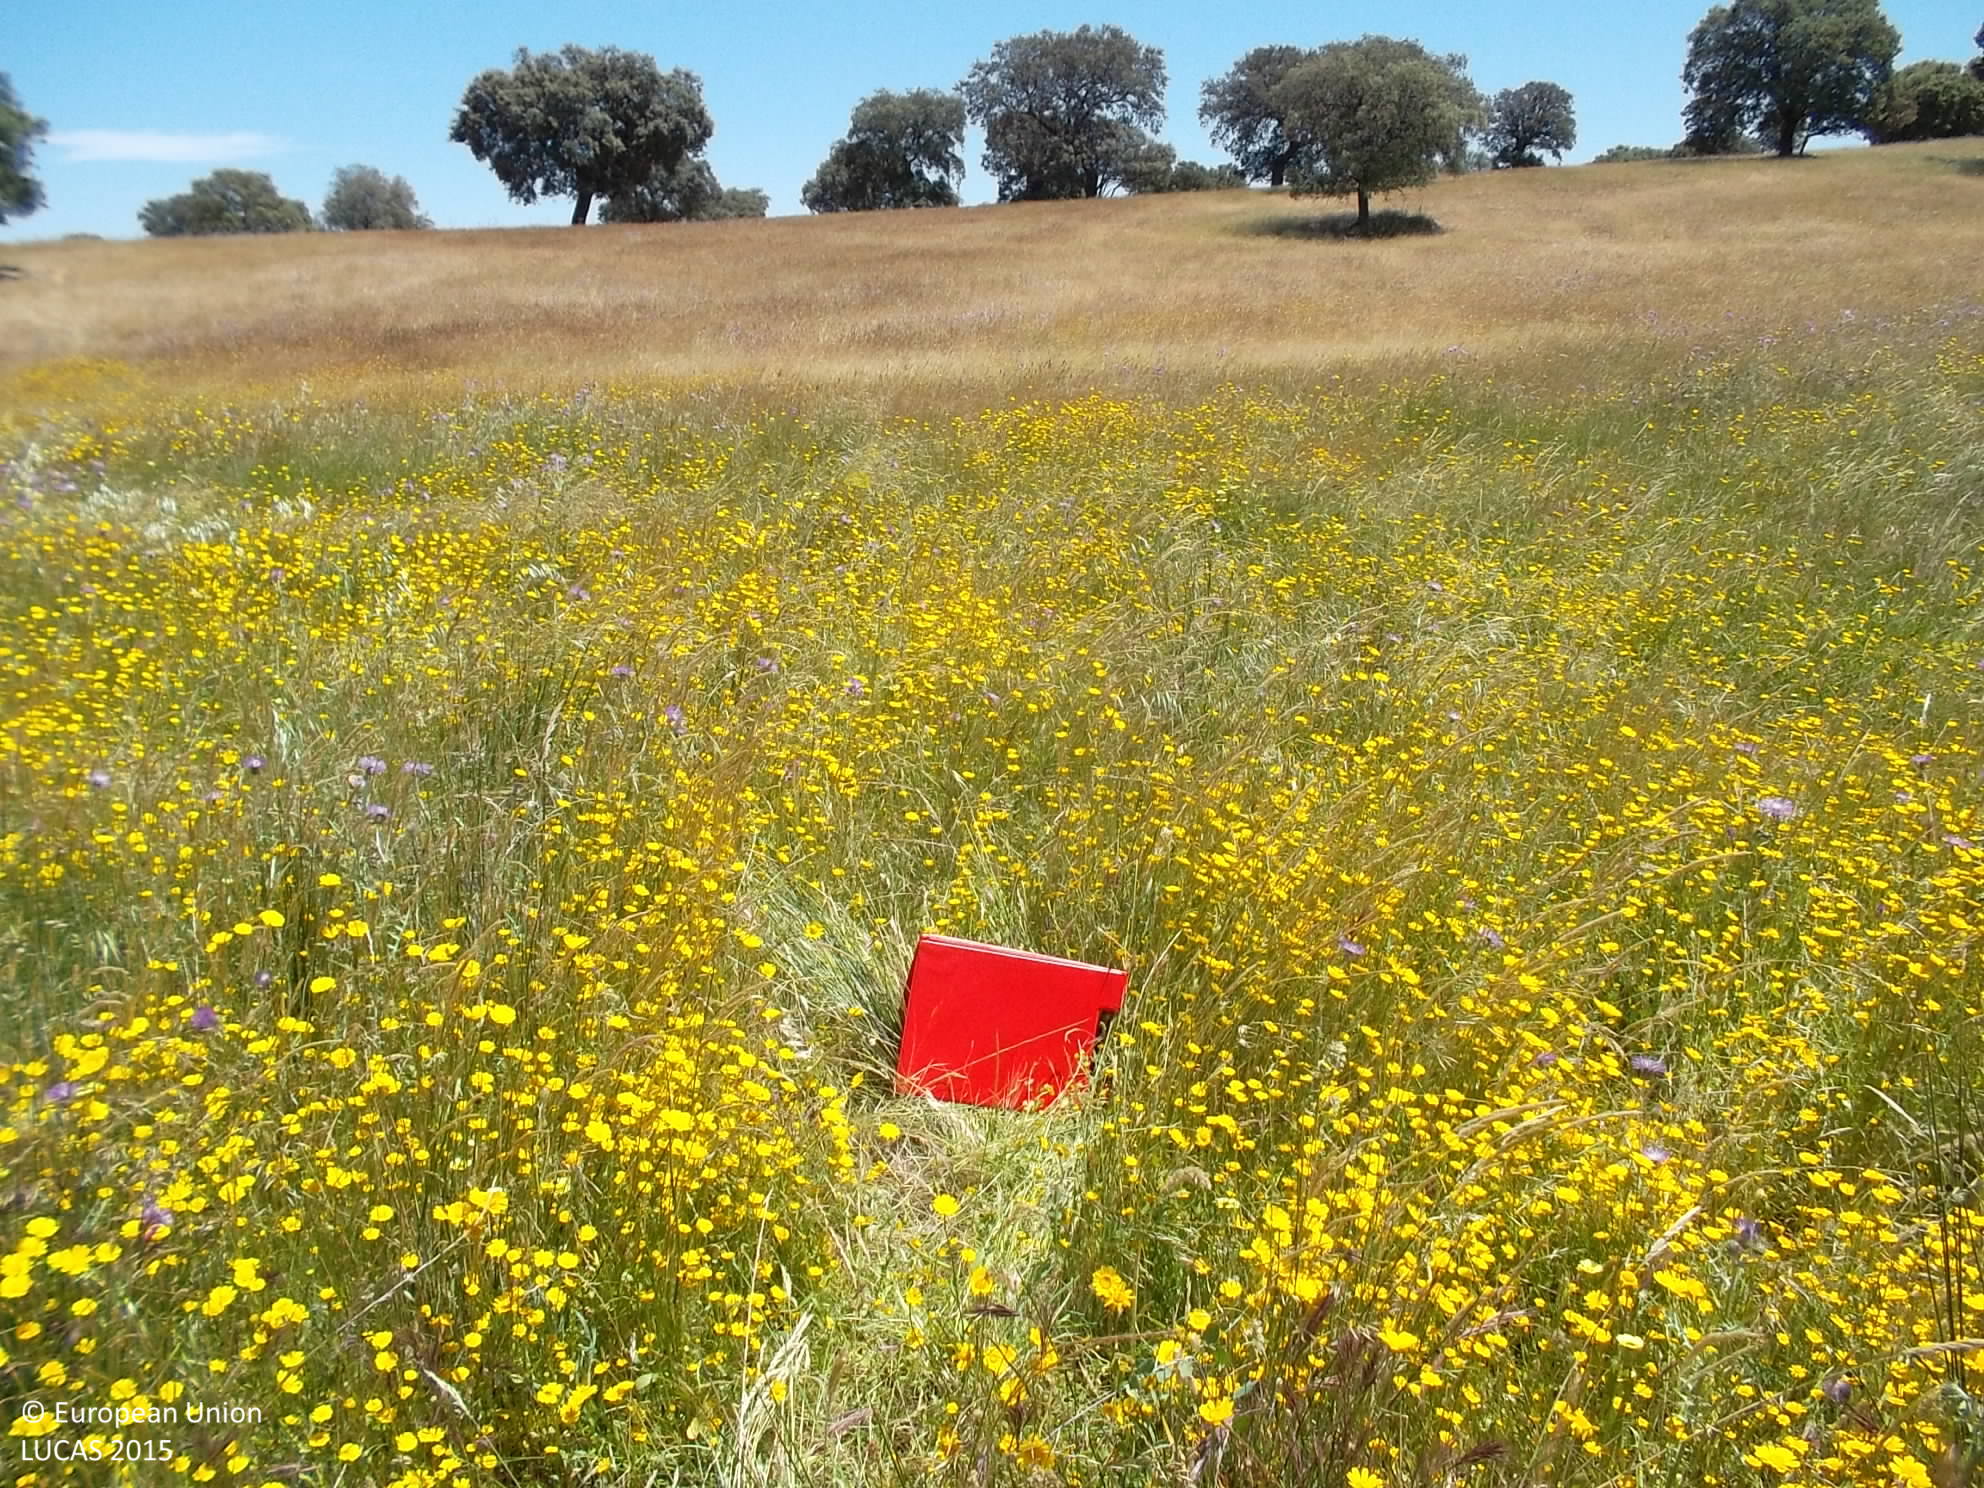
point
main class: Grassland
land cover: Grassland with sparse tree/shrub cover
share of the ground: > 75 %
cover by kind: herbaceous plants 95 %, broadleaved forest trees 5 %
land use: Agriculture (excluding fallow land and kitchen gardens)
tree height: > 5 m
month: May
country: ES
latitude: 38.8976
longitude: -4.4502
